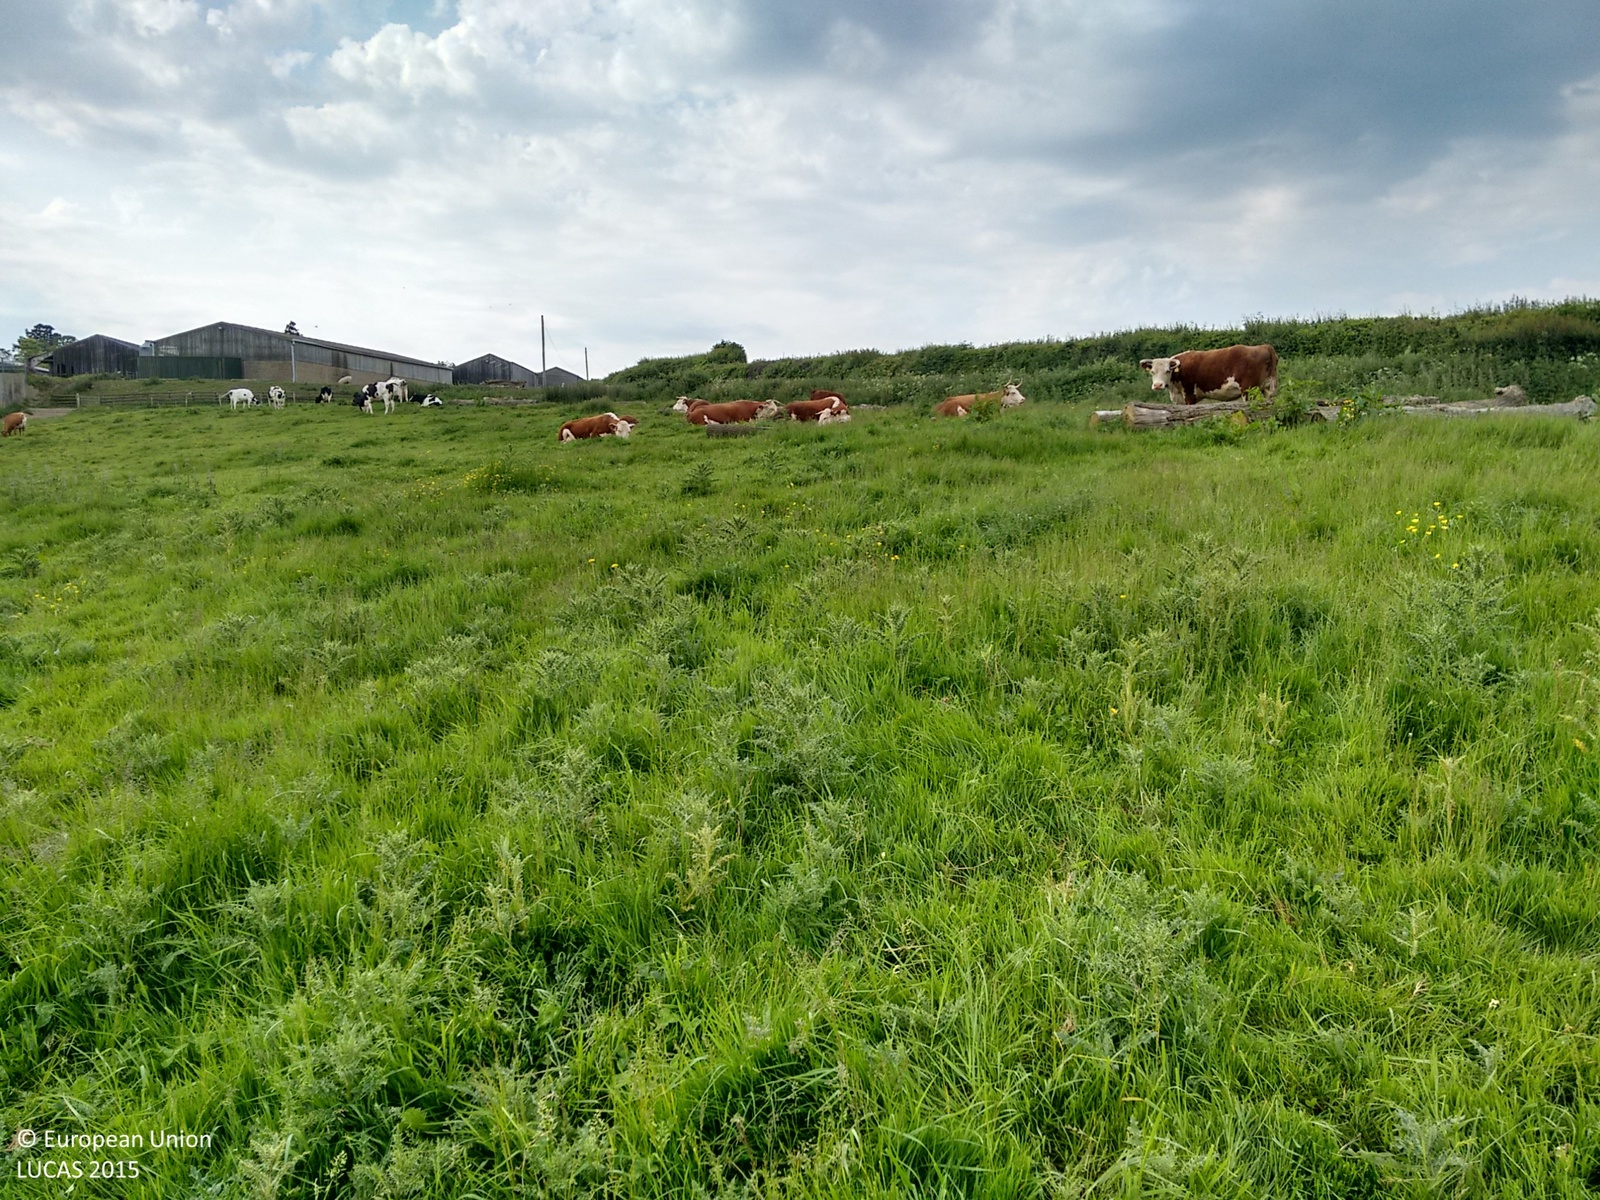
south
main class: Grassland
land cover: Grassland without tree/shrub cover
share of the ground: > 75 %
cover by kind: herbaceous plants 100 %
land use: Agriculture (excluding fallow land and kitchen gardens)
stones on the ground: < 10 %
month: June
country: GB
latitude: 51.0870
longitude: 0.6798
